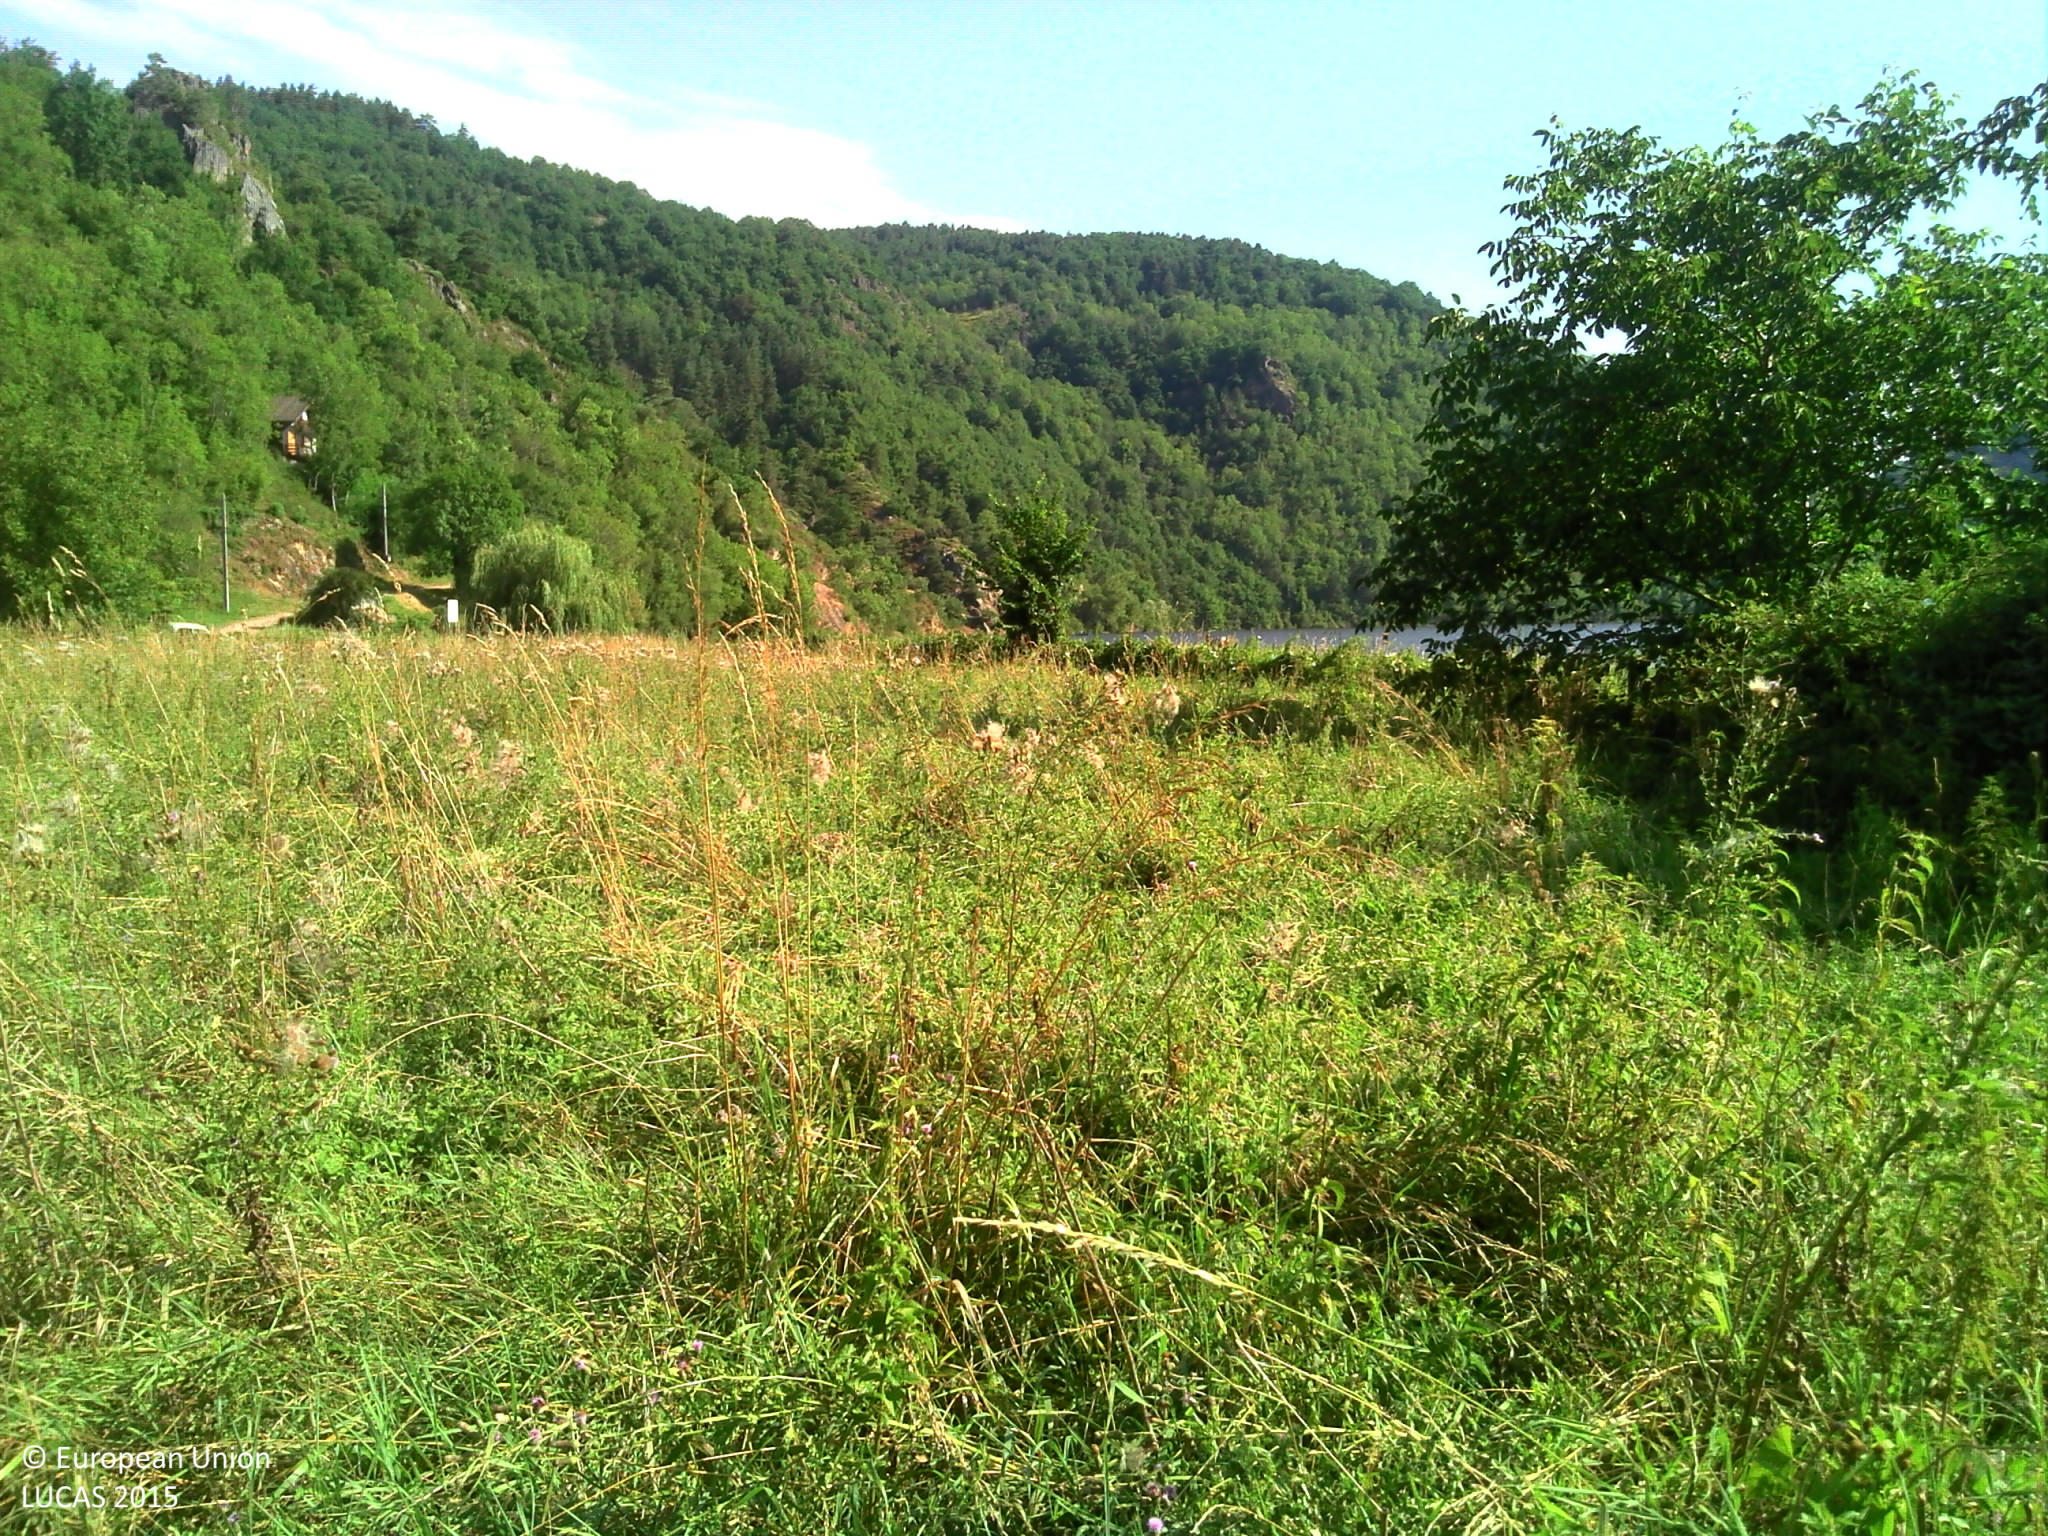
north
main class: Grassland
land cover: Spontaneously vegetated surfaces
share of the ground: > 75 %
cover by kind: herbaceous plants 100 %
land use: Semi-natural and natural areas not in use
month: July
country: FR
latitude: 45.3821
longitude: 4.2184
